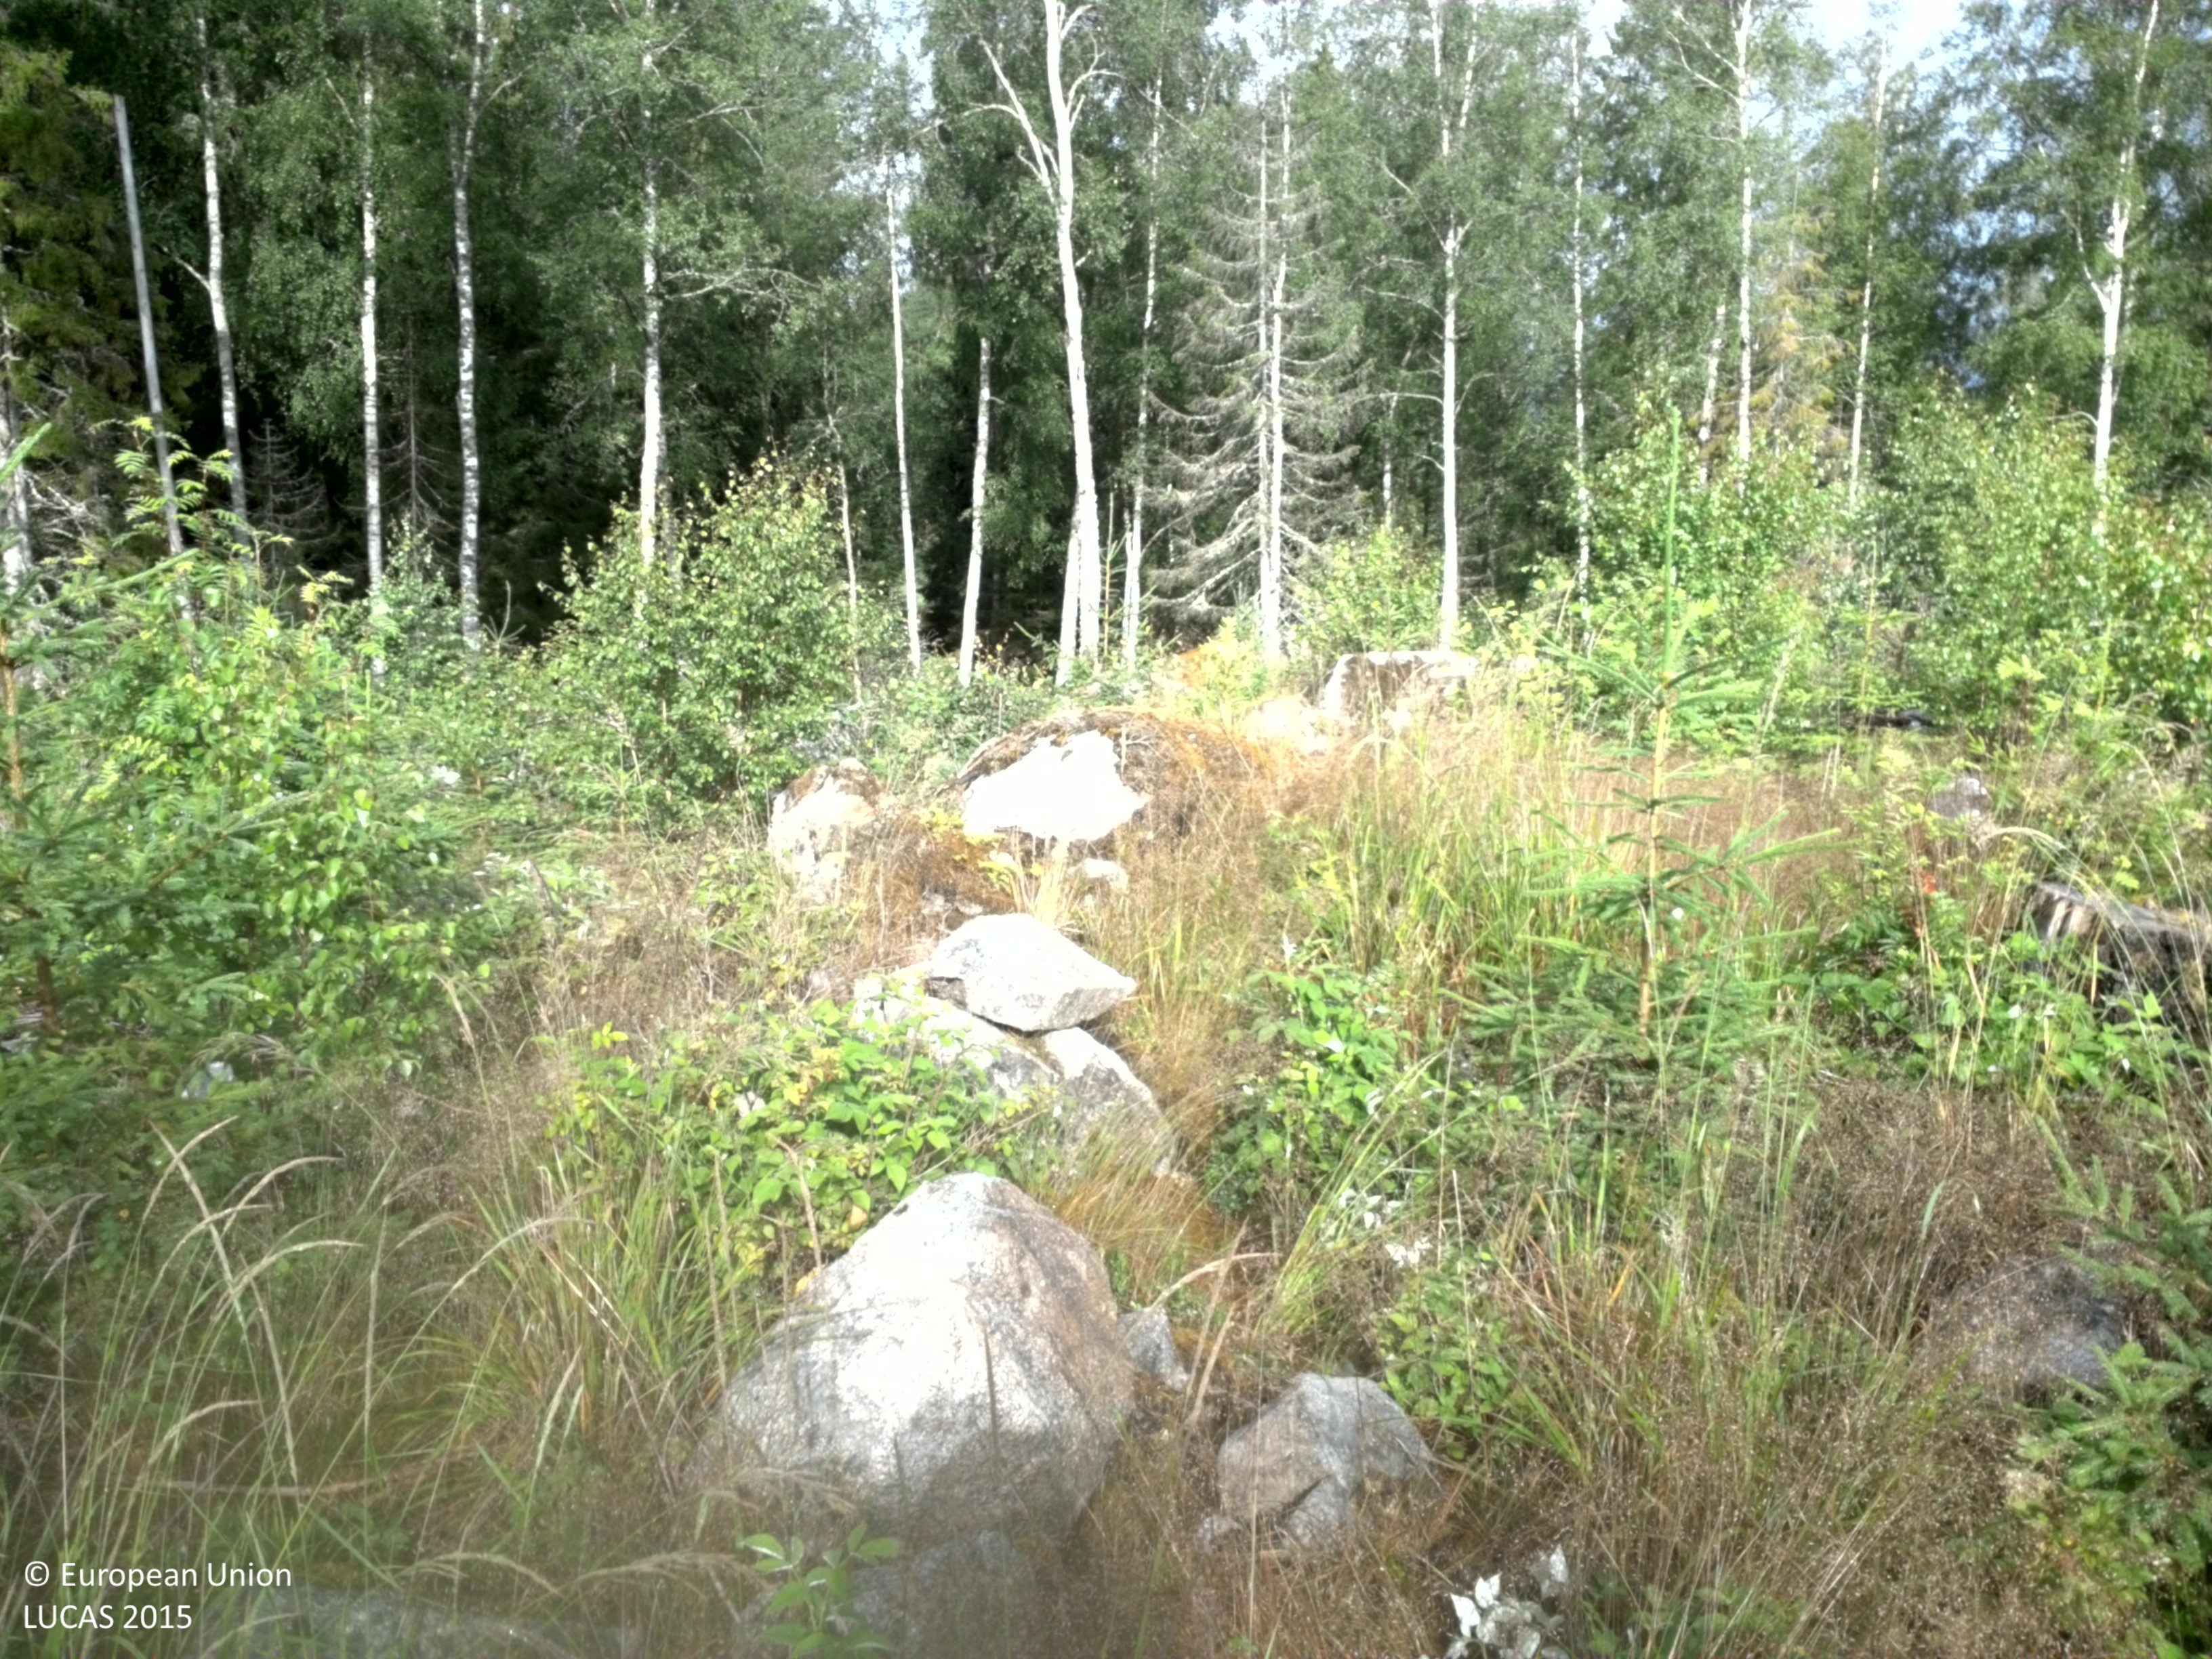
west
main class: Woodland
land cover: Broadleaved woodland
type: boreal forest
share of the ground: 25 - 50 %
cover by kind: herbaceous plants 50 %, broadleaved forest trees 40 %, coniferous forest trees 10 %
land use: Forestry
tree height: < 5 m
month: July
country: SE
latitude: 60.0656
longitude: 17.2683
